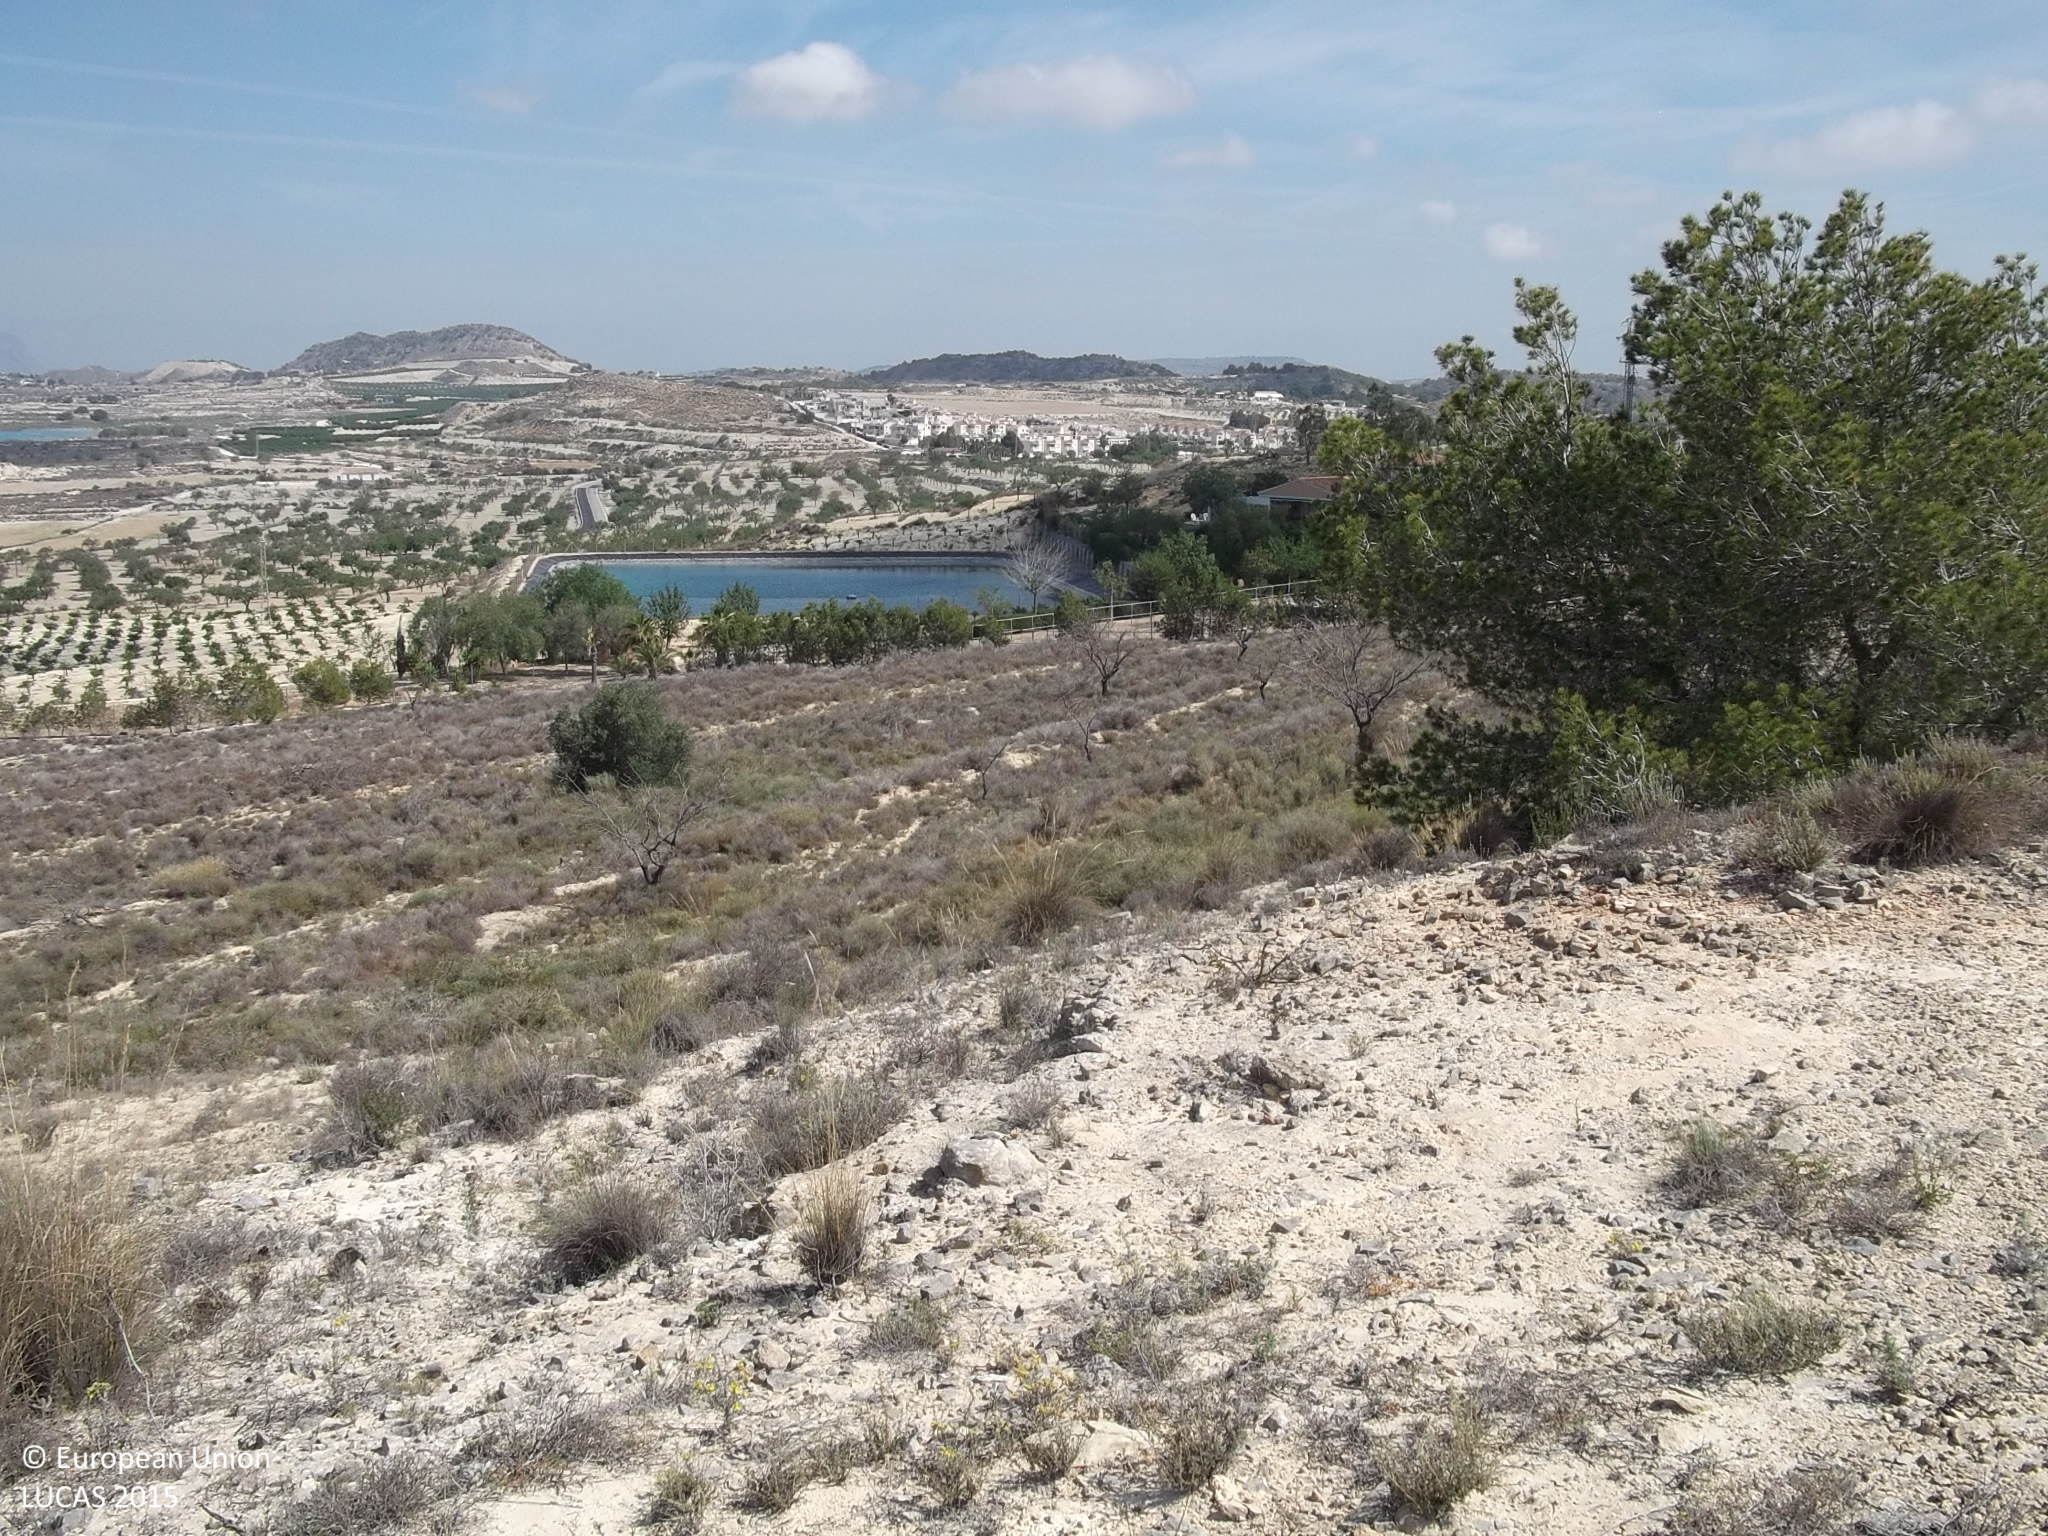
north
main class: Shrubland
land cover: Shrubland without tree cover
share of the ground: 25 - 50 %
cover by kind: shrubs 40 %, herbaceous plants 30 %, consolidated bare surface 30 %
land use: Semi-natural and natural areas not in use
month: May
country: ES
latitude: 37.9859
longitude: -0.8332
